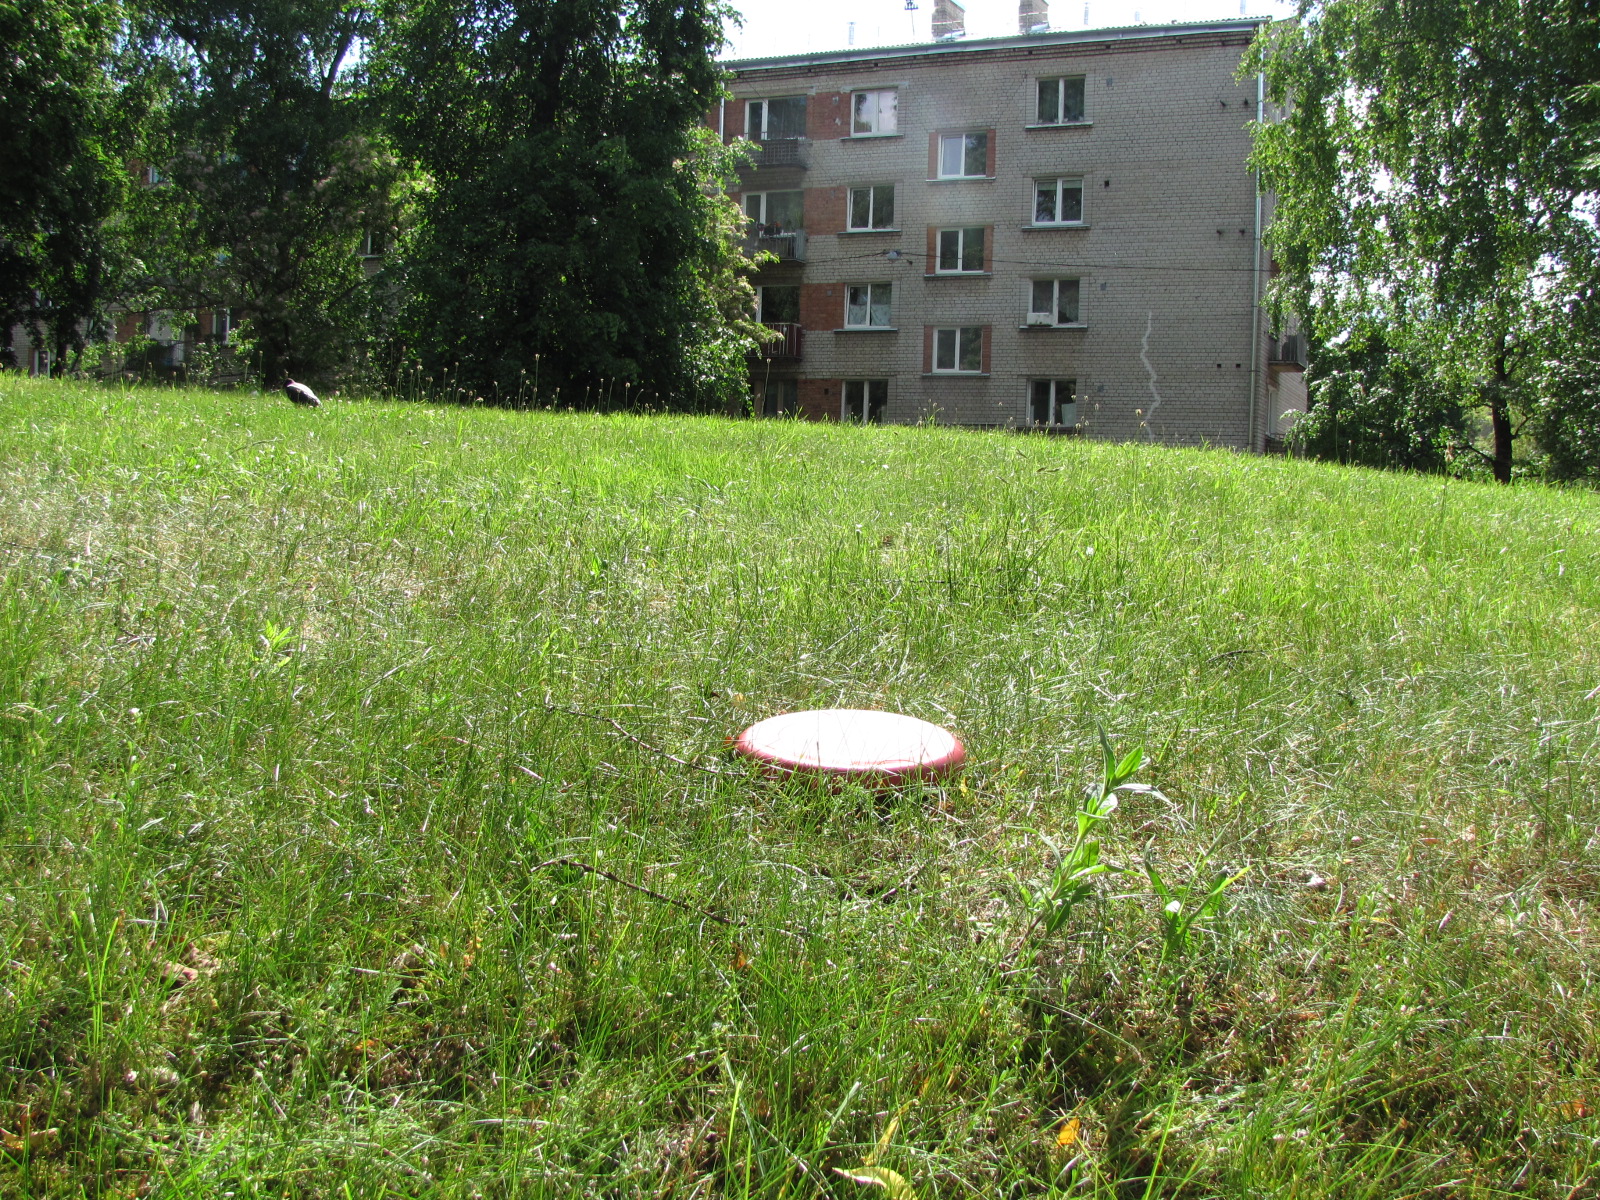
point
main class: Grassland
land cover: Grassland with sparse tree/shrub cover
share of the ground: > 75 %
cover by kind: herbaceous plants 95 %, broadleaved forest trees 5 %
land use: Residential
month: June
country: LV
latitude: 56.9642
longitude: 24.0474
